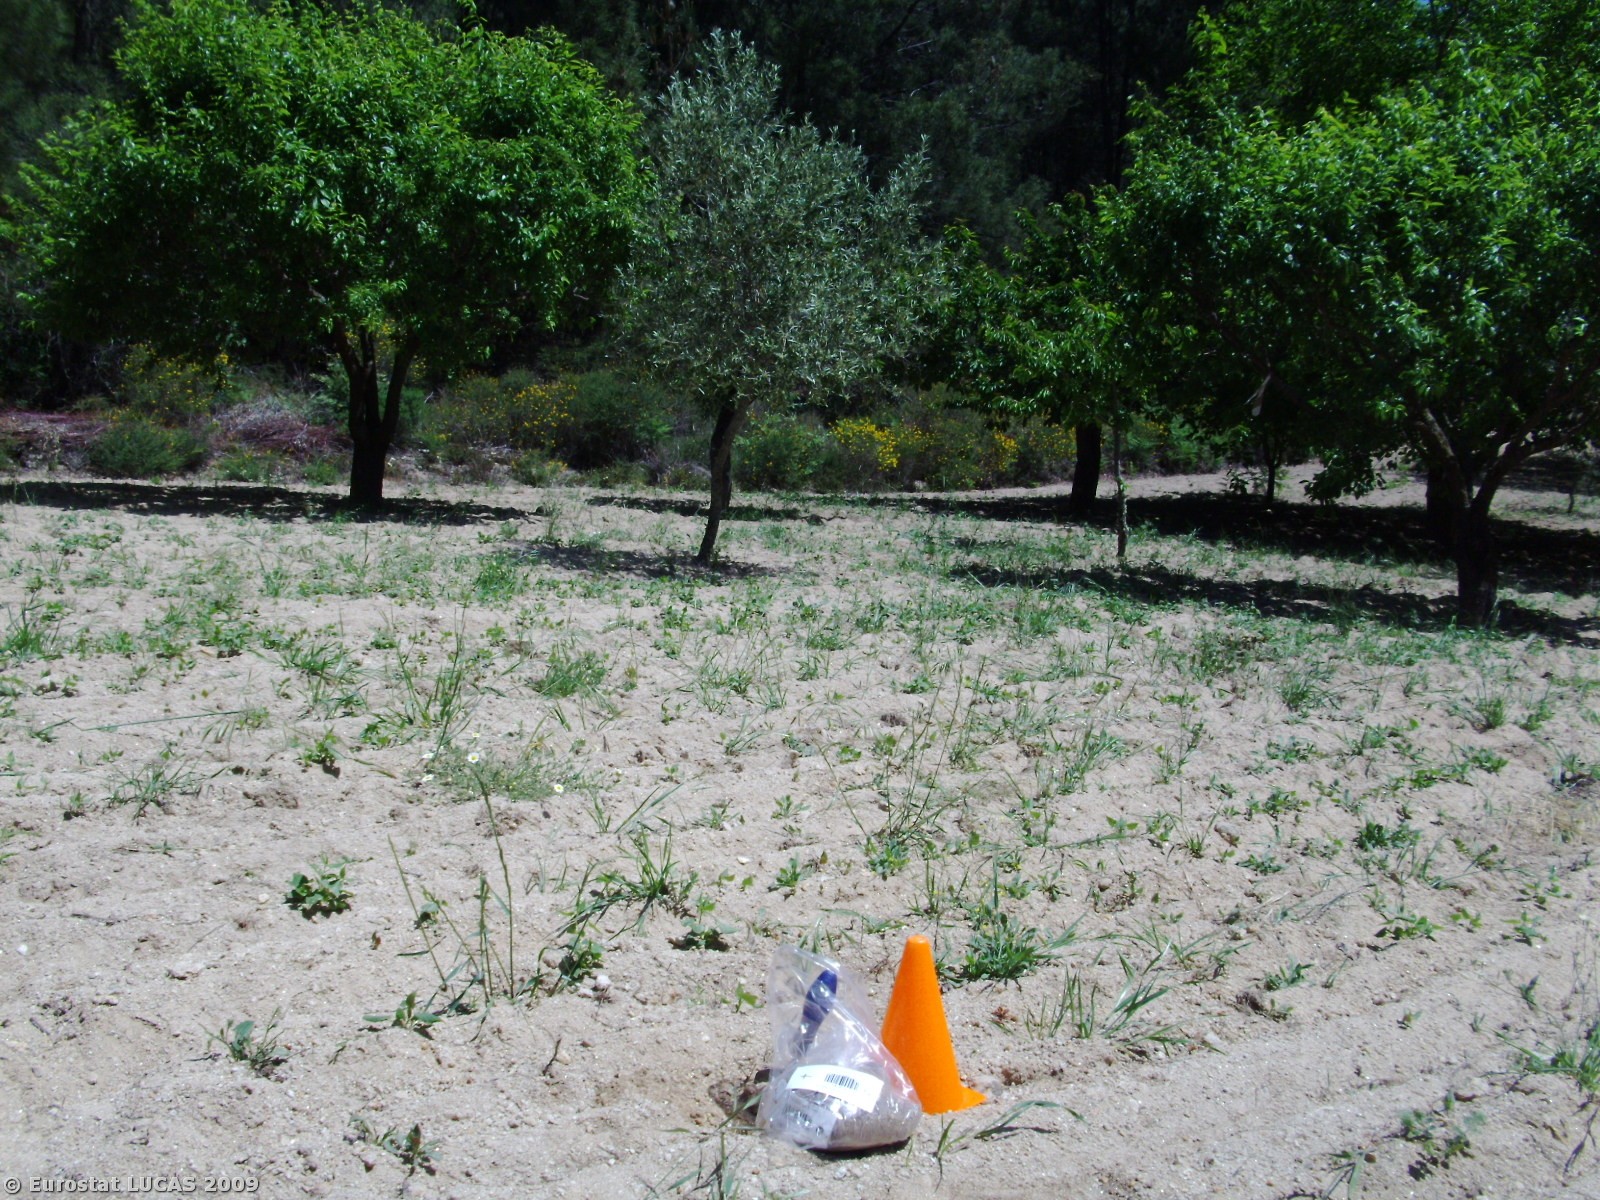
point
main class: Cropland
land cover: Olive groves
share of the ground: 50 - 75 %
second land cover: Cherry fruit
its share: 25 - 50 %
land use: Agriculture (excluding fallow land and kitchen gardens)
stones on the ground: 25 - 50 %
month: May
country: PT
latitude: 40.8176
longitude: -7.3145
